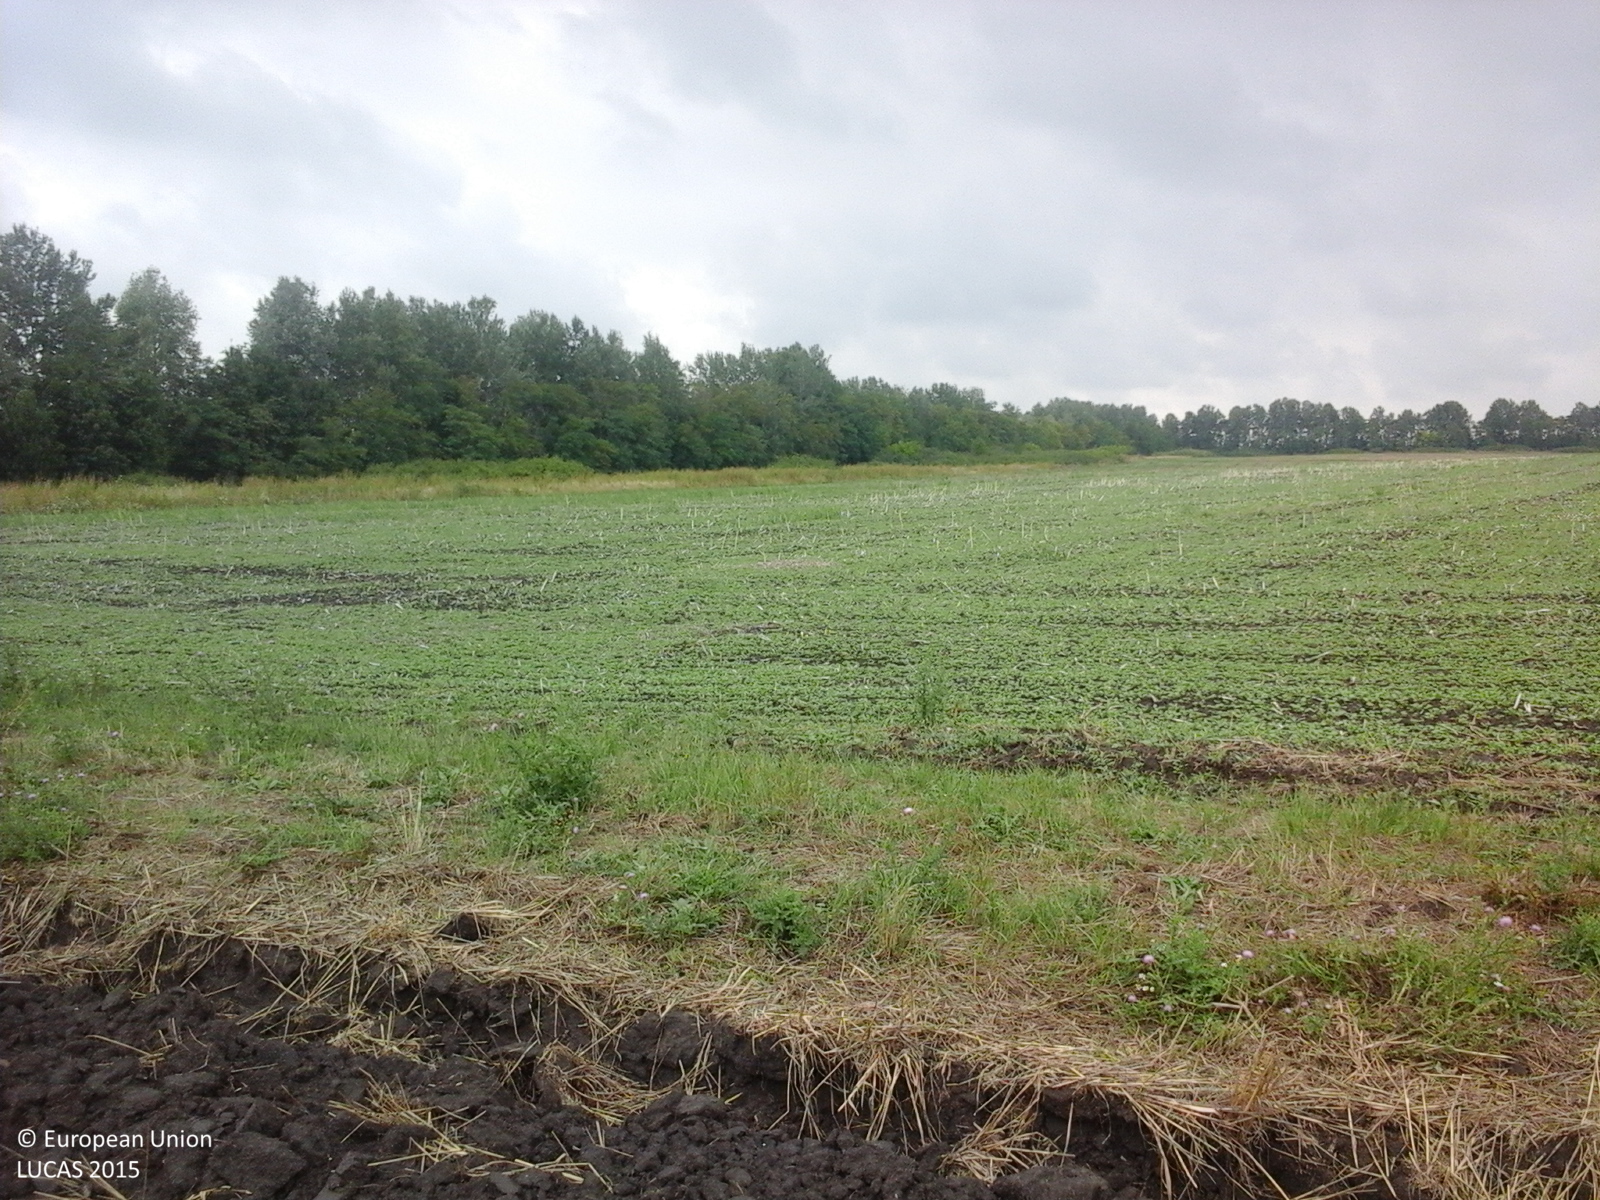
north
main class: Cropland
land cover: Common wheat
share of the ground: < 10 %
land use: Agriculture (excluding fallow land and kitchen gardens)
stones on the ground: < 10 %
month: August
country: RO
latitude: 46.1520
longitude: 20.3951
